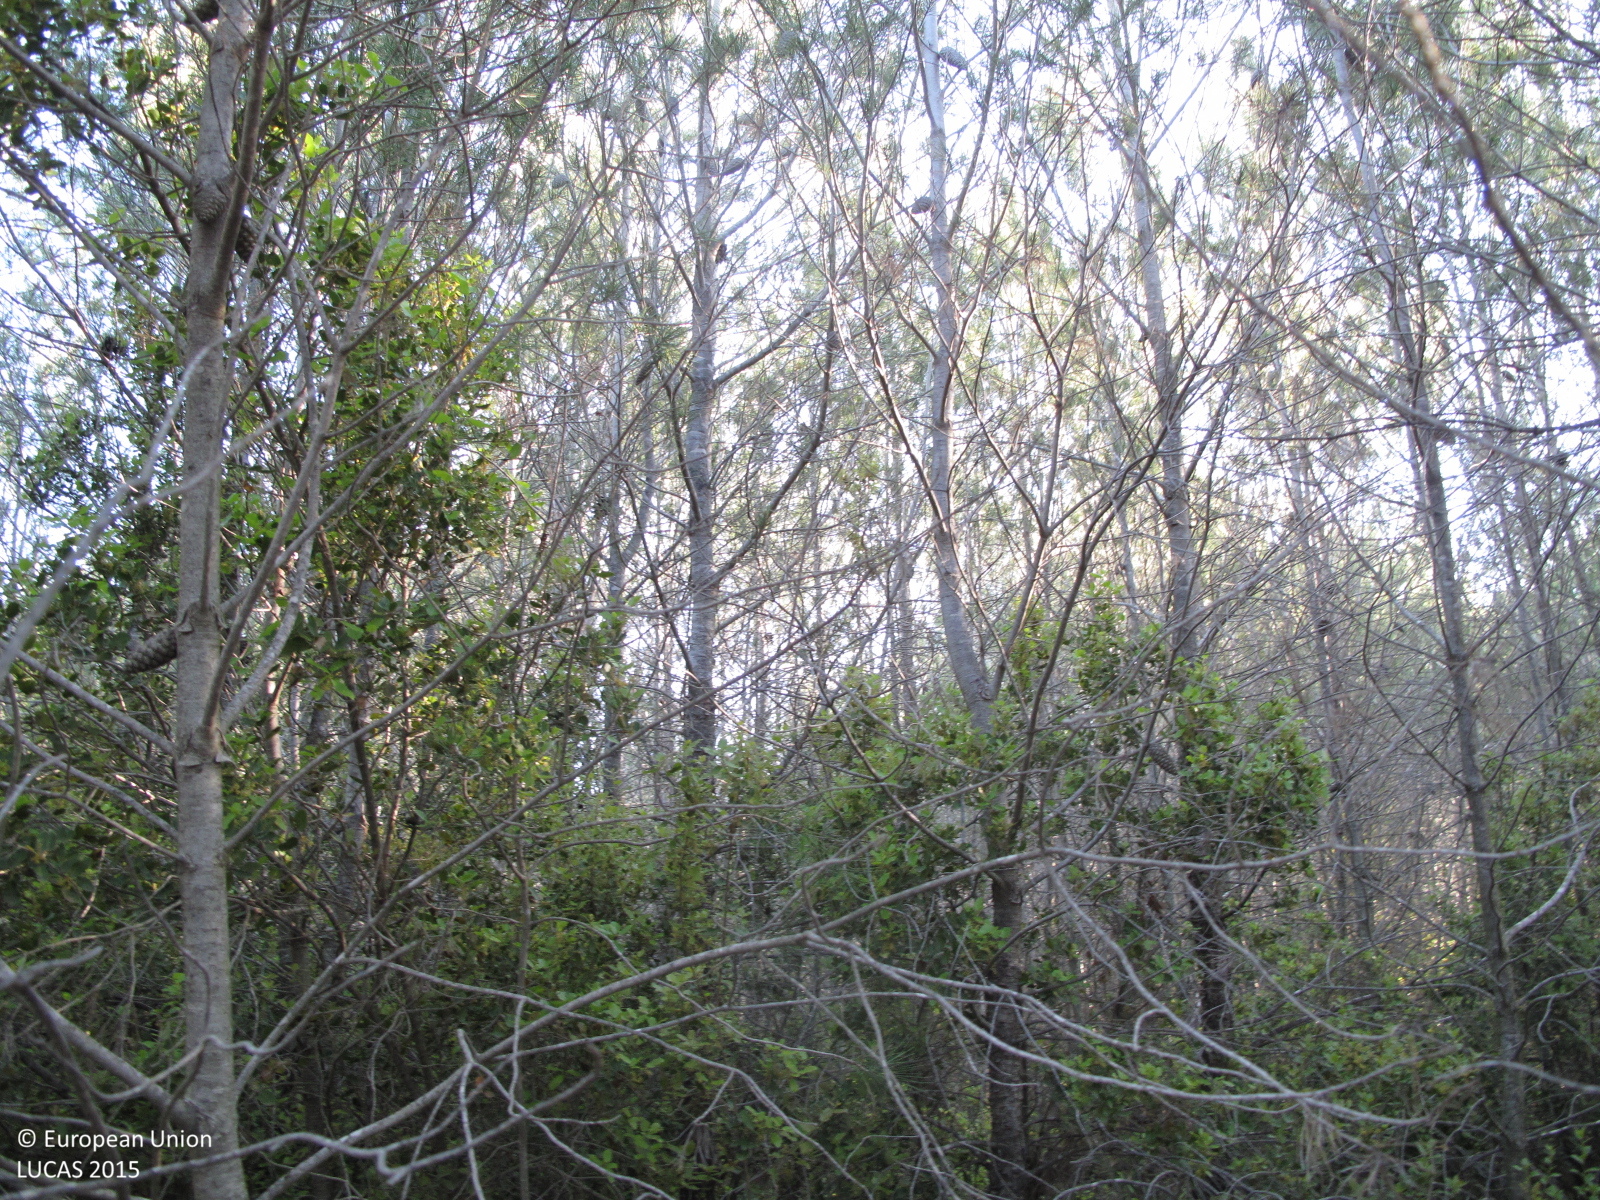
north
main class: Woodland
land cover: Pine dominated coniferous woodland
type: coniferous forest of the mediterranean region
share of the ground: > 75 %
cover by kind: coniferous forest trees 100 %
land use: Semi-natural and natural areas not in use
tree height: > 5 m
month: May
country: ES
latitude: 38.8284
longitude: -0.4845
